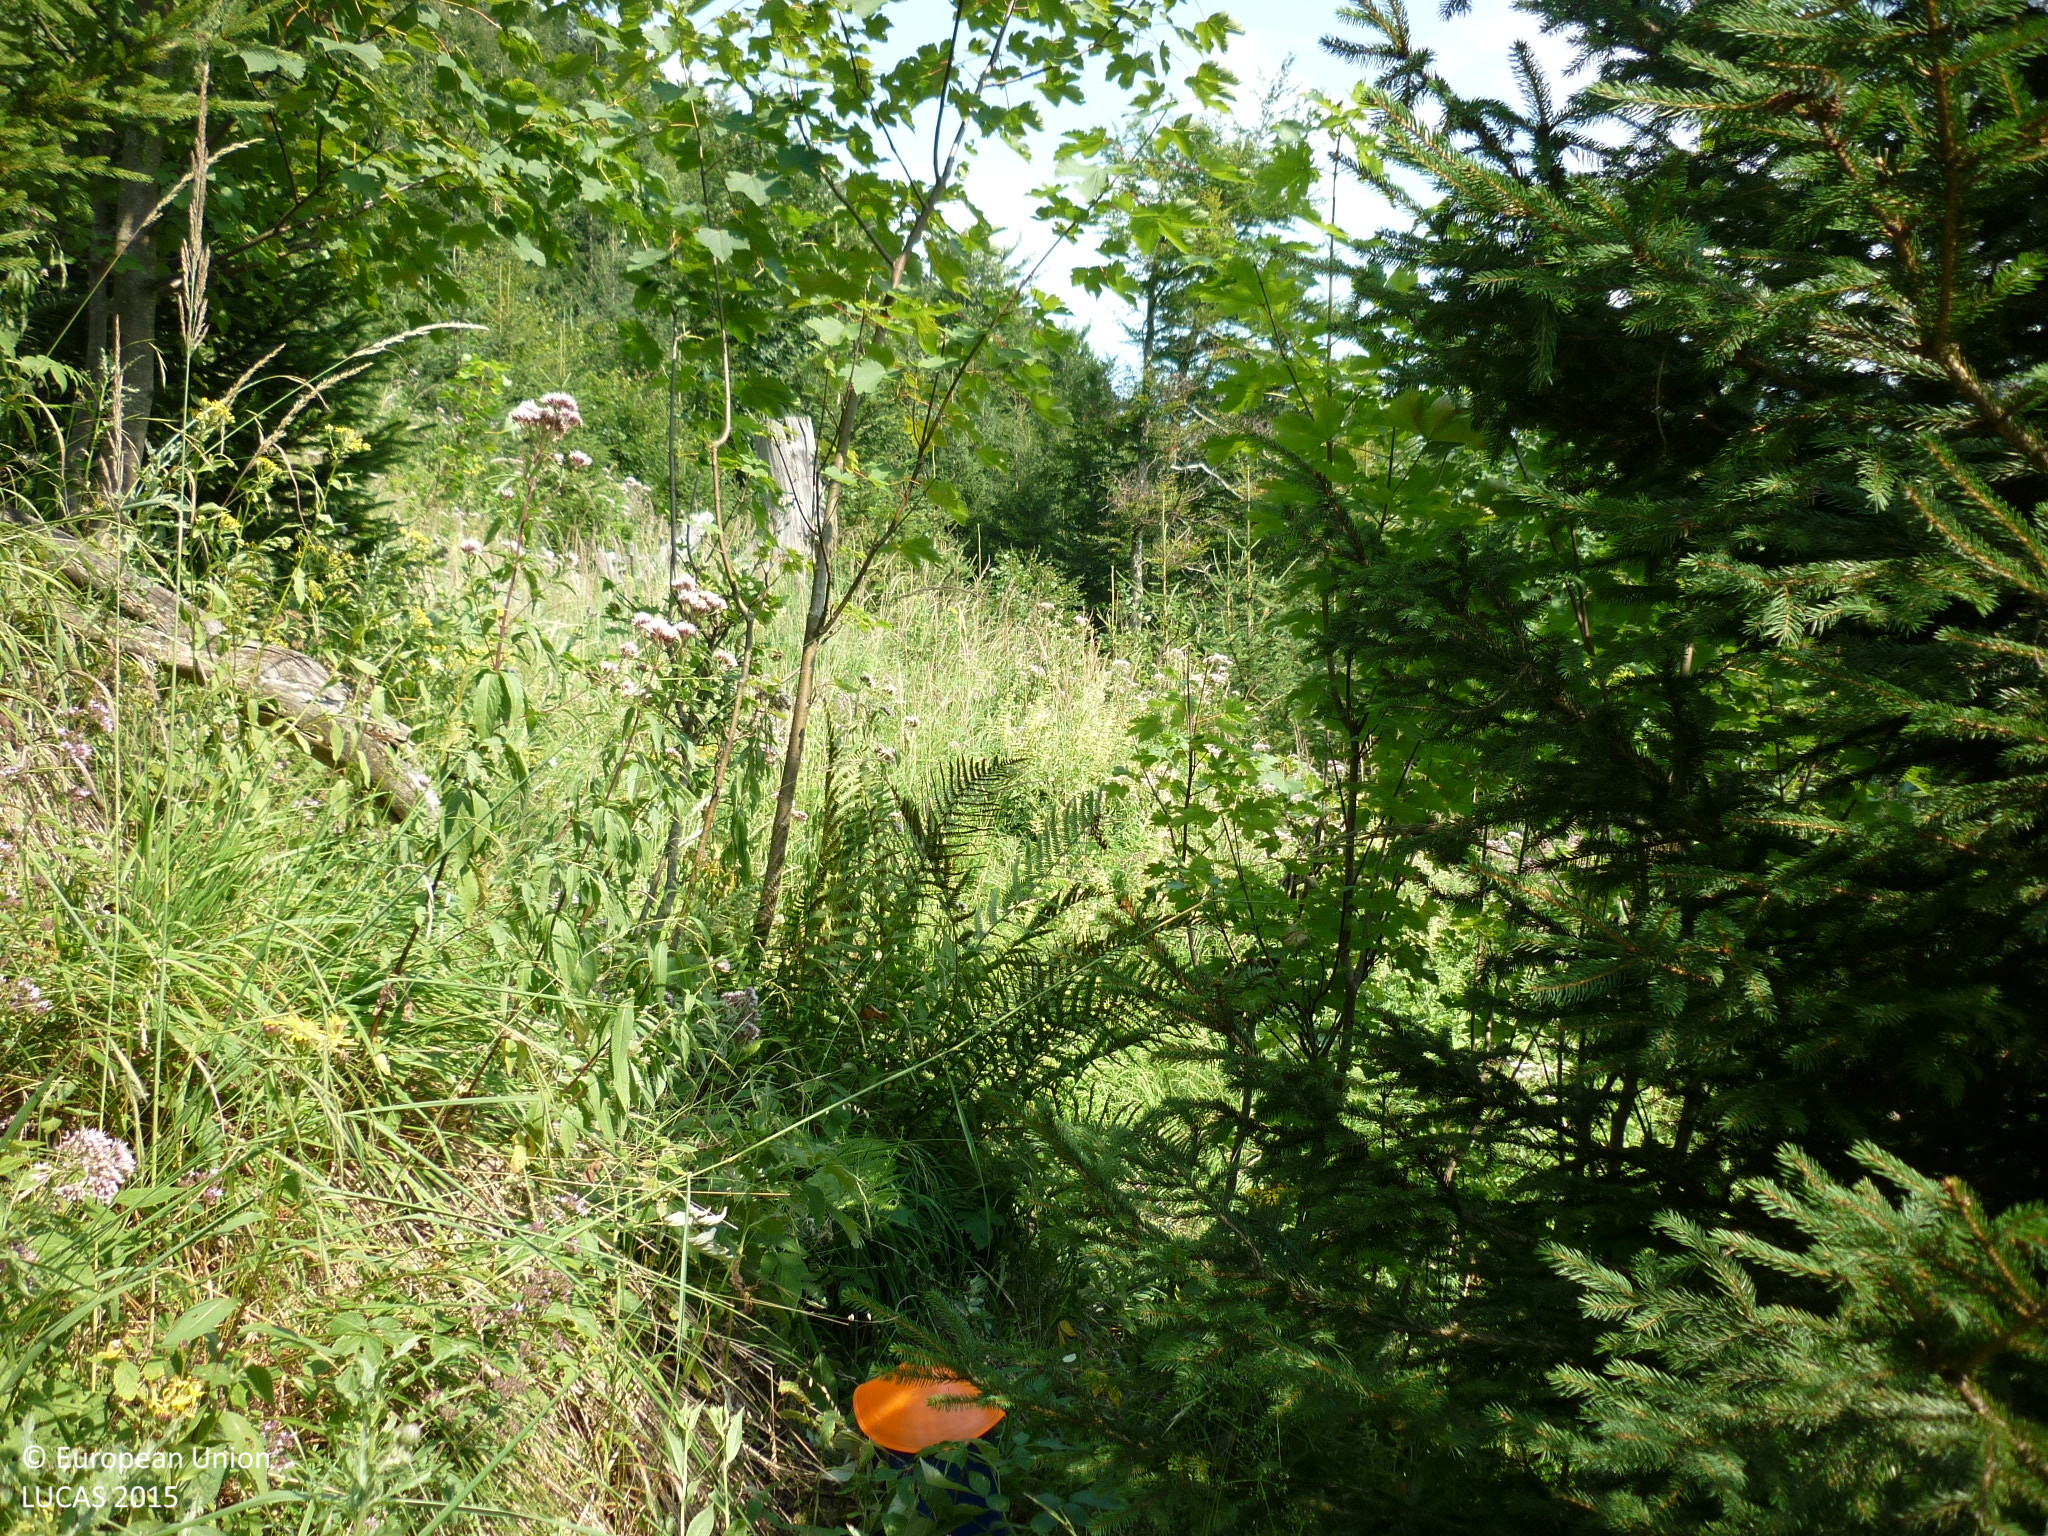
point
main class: Woodland
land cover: Spruce dominated mixed woodland
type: alpine coniferous forest
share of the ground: > 75 %
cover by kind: coniferous forest trees 40 %, broadleaved forest trees 40 %, shrubs 10 %, herbaceous plants 10 %
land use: Forestry
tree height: > 5 m
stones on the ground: 10 - 25 %
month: August
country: AT
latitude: 47.7692
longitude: 14.5498
